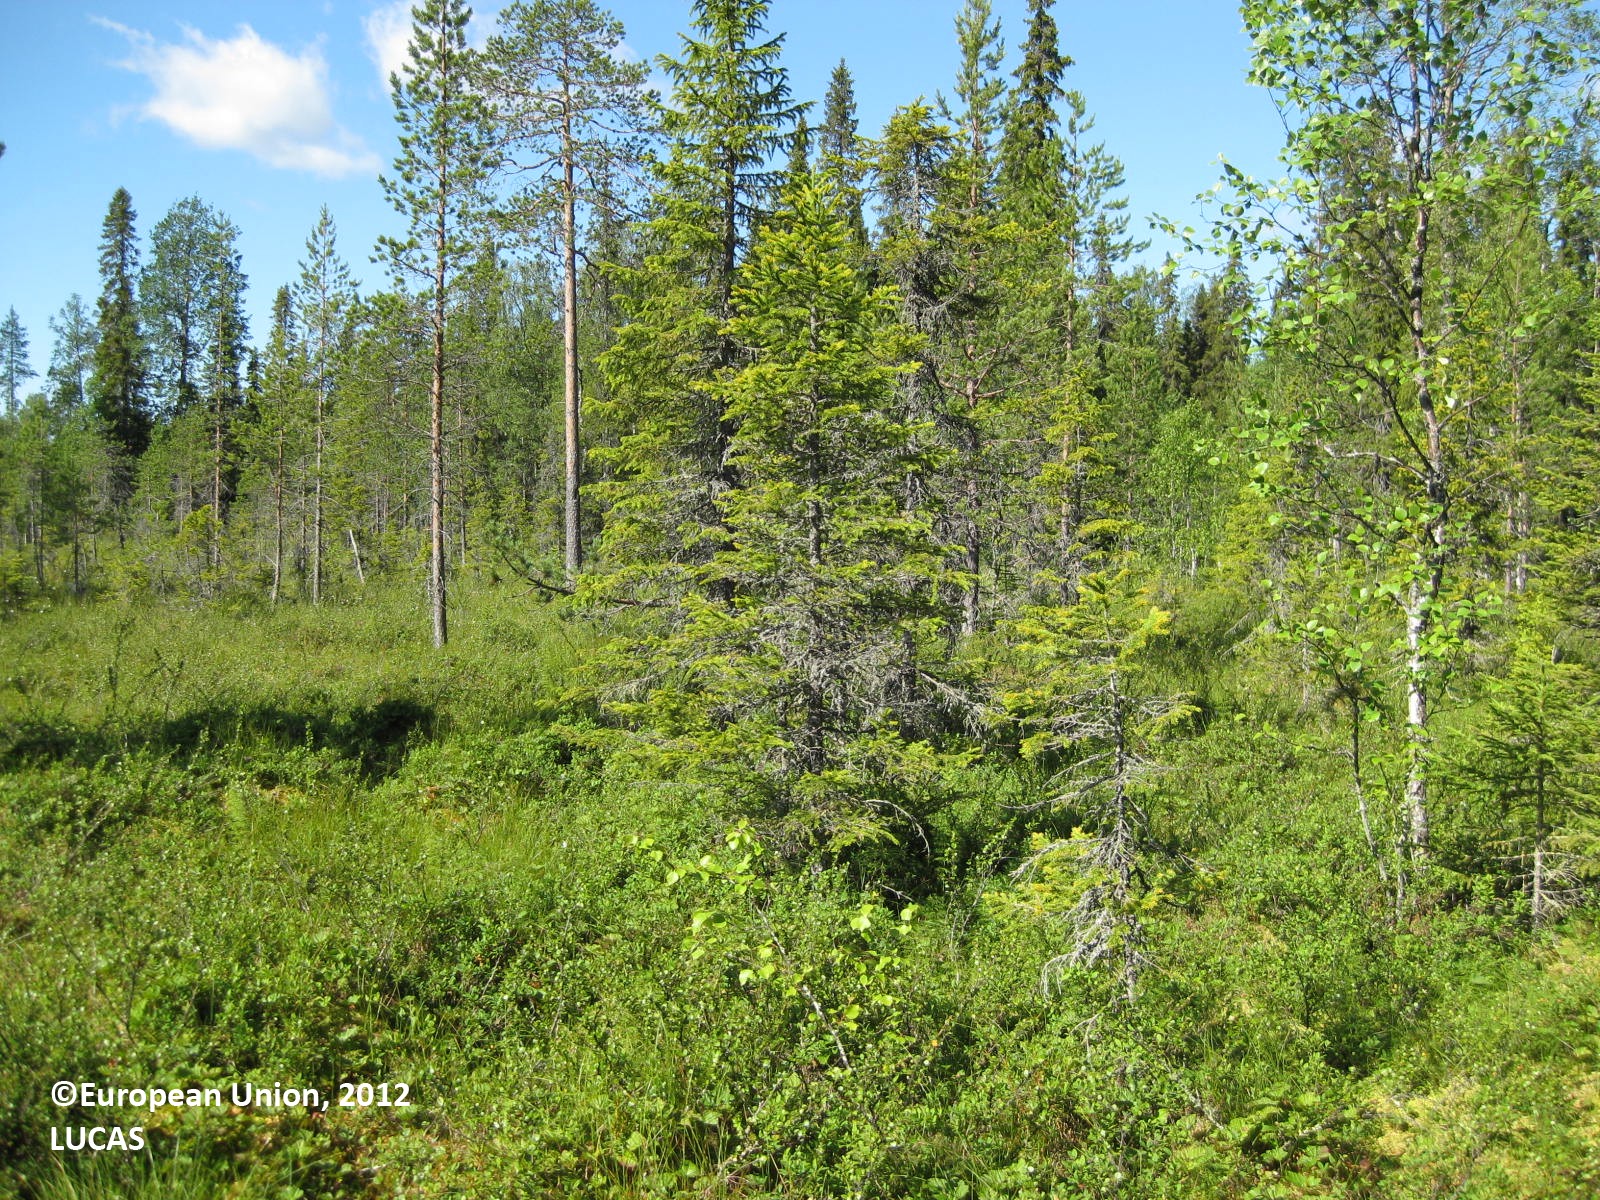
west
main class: Woodland
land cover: Spruce dominated mixed woodland
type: boreal forest
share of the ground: 50 - 75 %
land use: Semi-natural and natural areas not in use
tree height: > 5 m
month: July
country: FI
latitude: 65.5869
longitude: 28.3922
